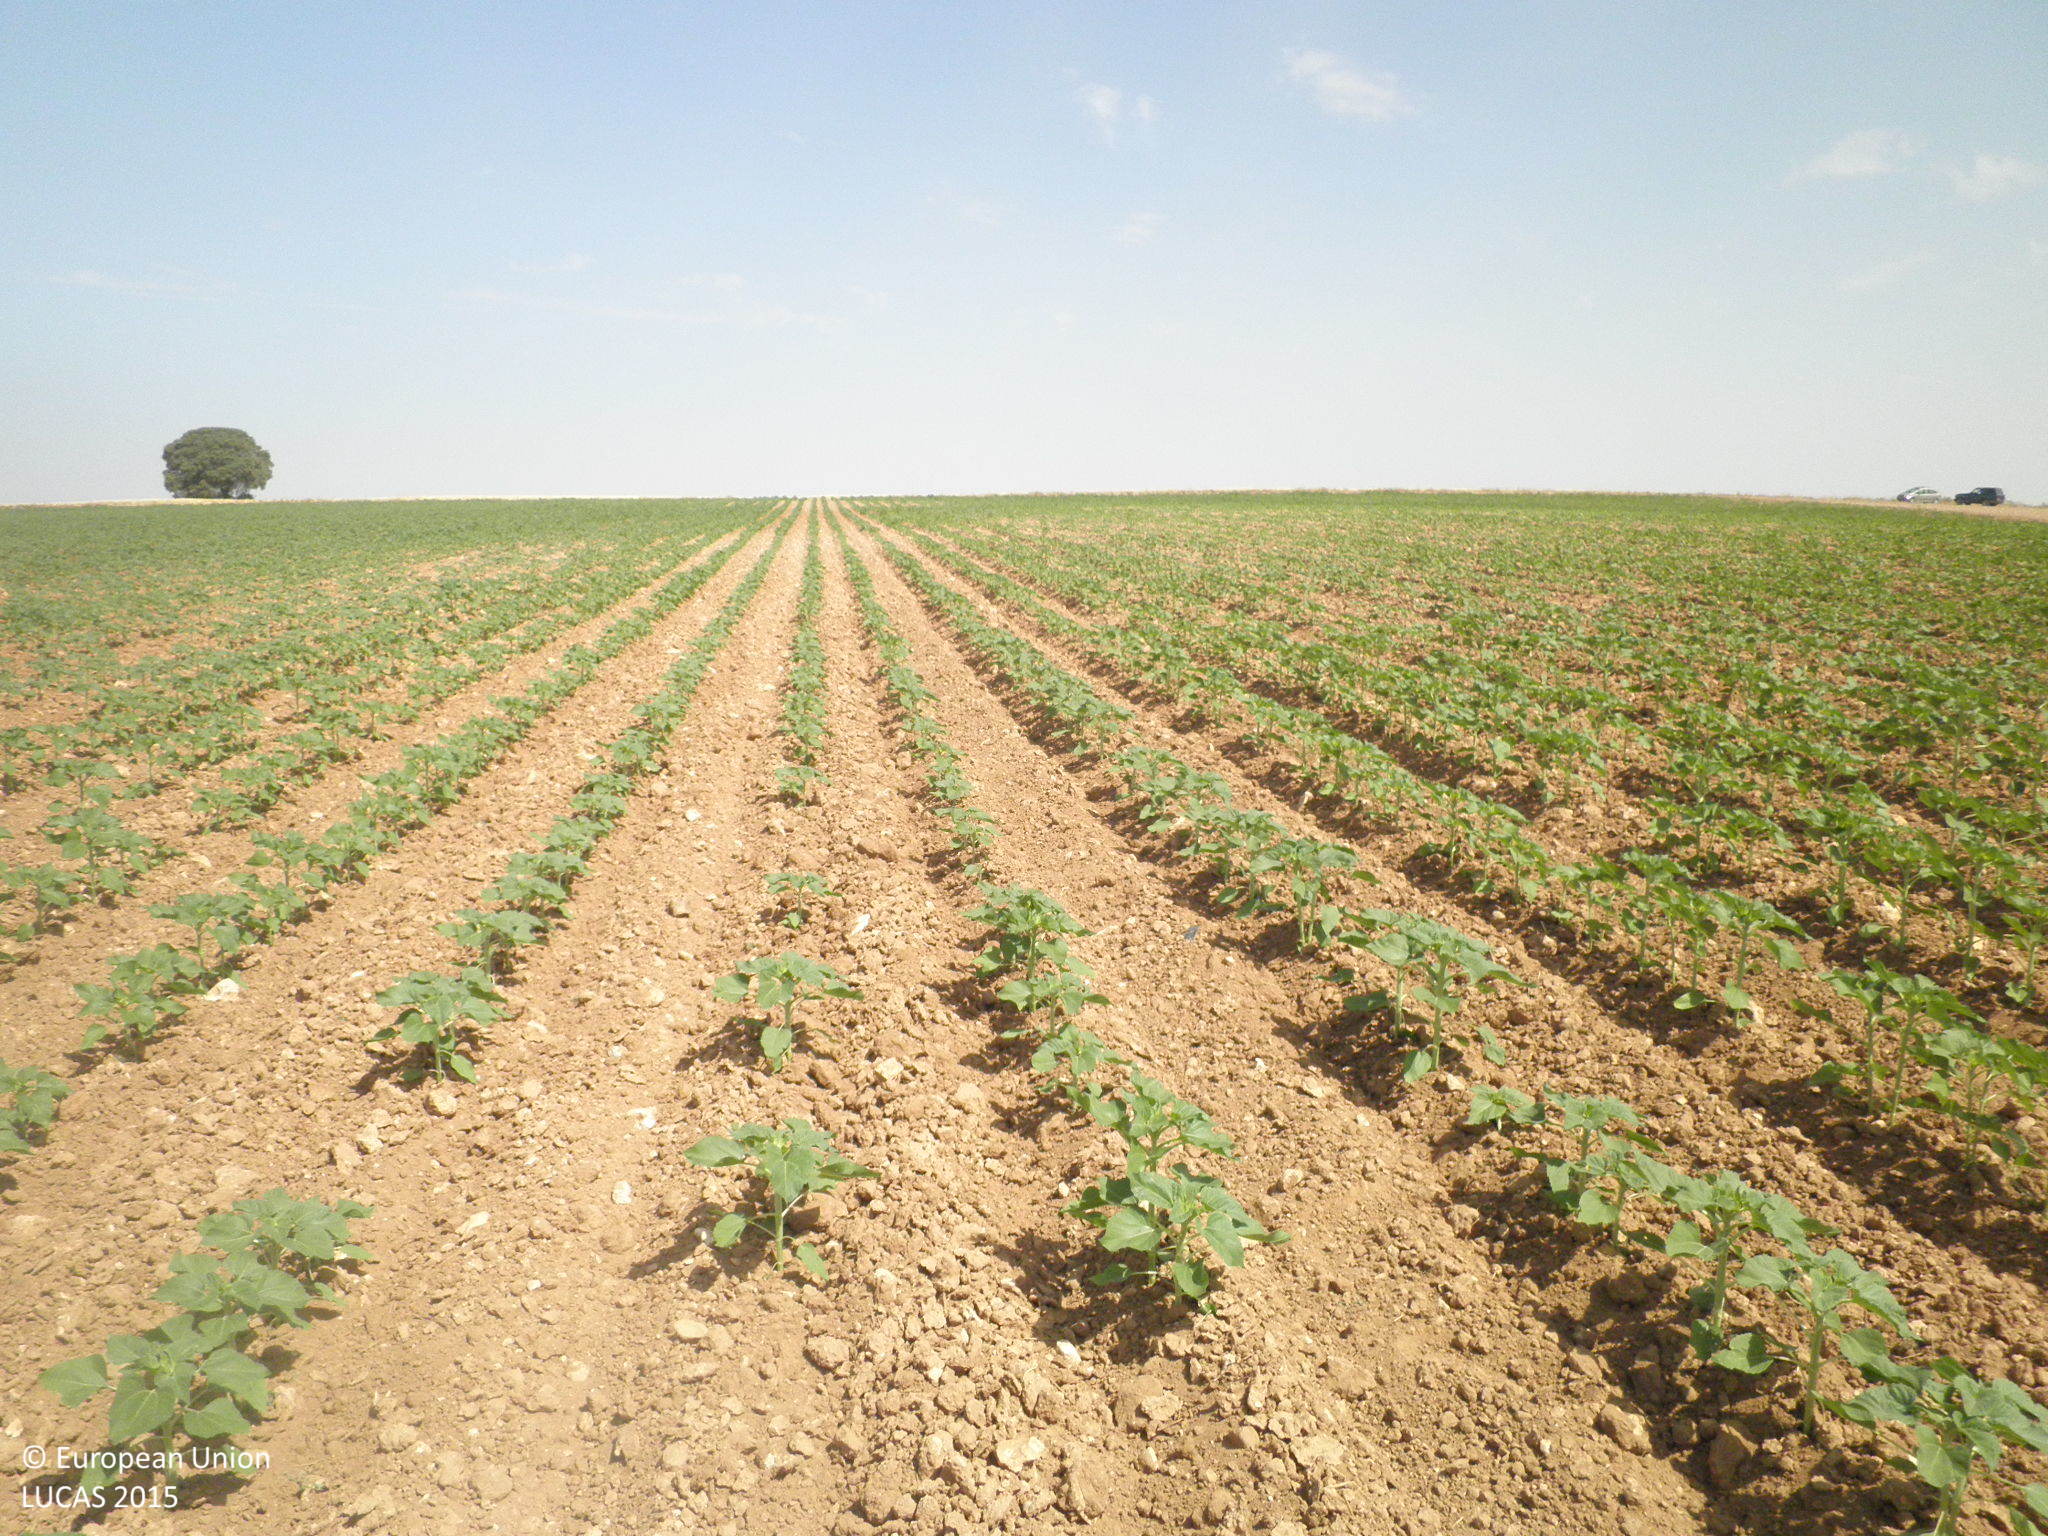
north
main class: Cropland
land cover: Sunflower
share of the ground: < 10 %
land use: Agriculture (excluding fallow land and kitchen gardens)
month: July
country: ES
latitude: 39.5199
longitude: -2.7756
